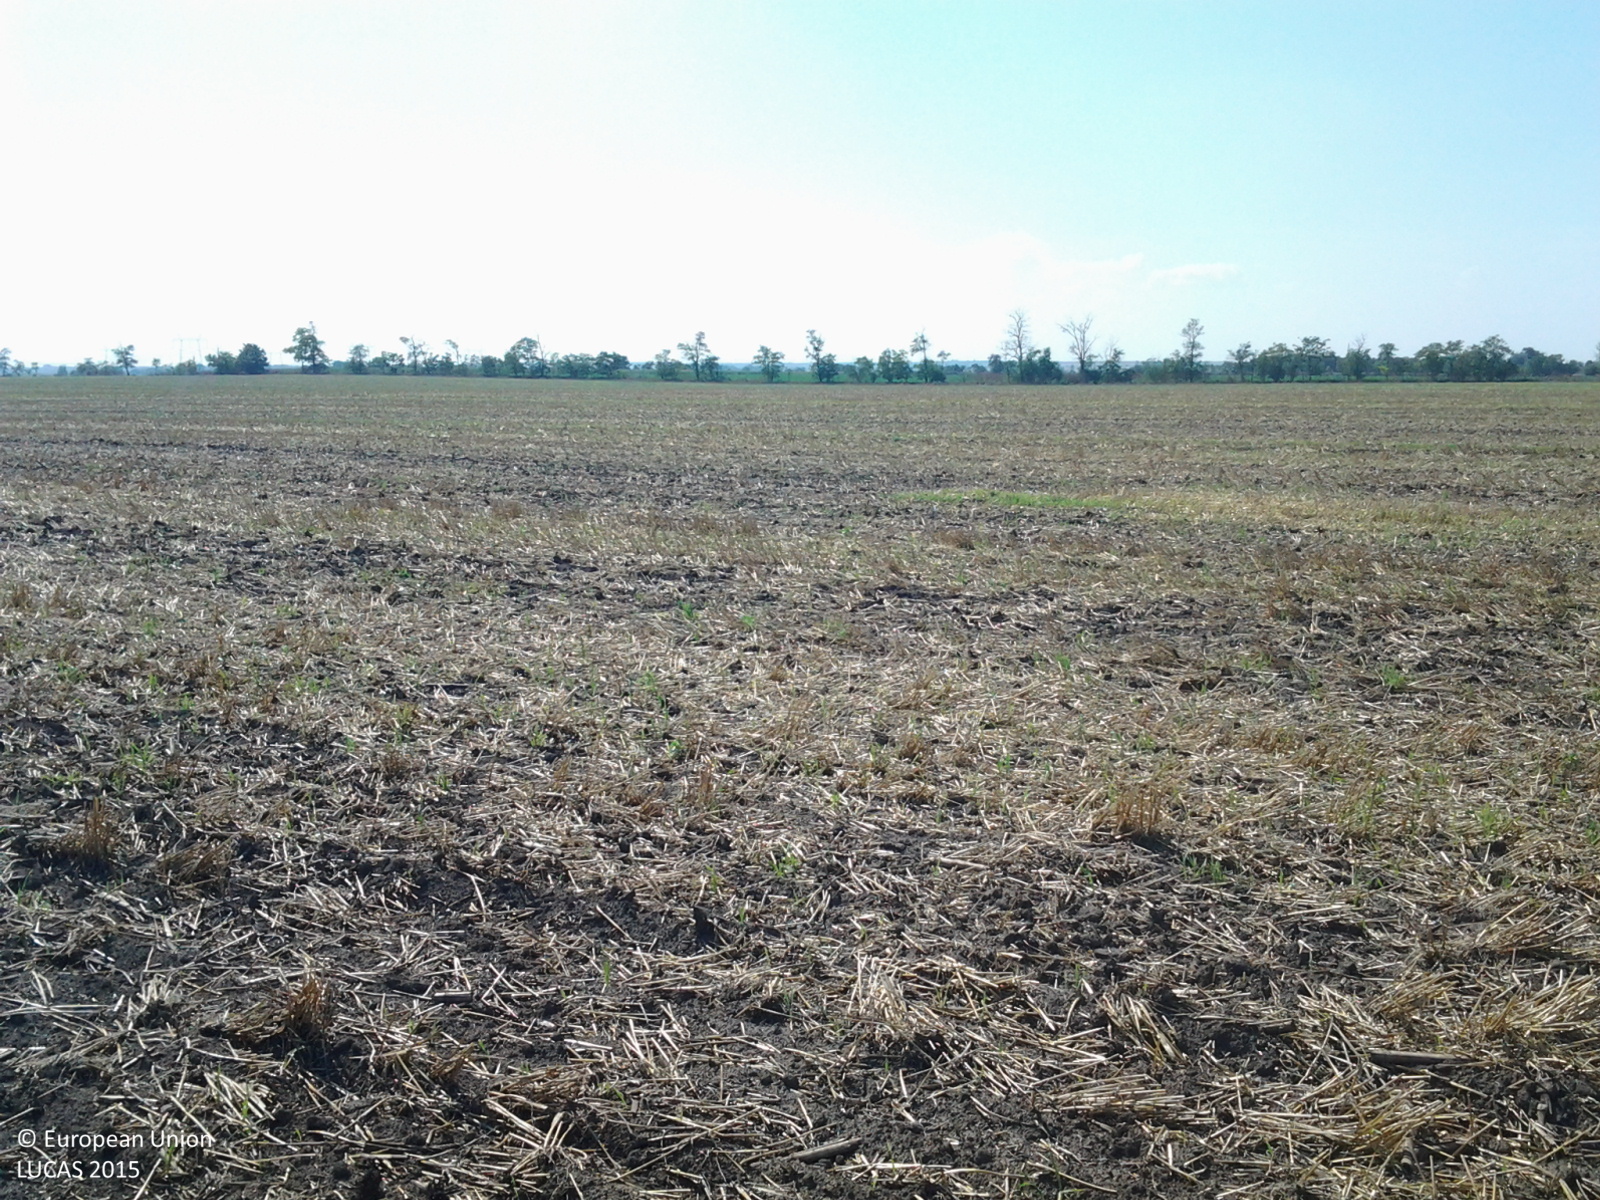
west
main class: Cropland
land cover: Barley
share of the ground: 10 - 25 %
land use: Agriculture (excluding fallow land and kitchen gardens)
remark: Harvested field
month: August
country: HU
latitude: 47.2434
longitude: 19.7860
